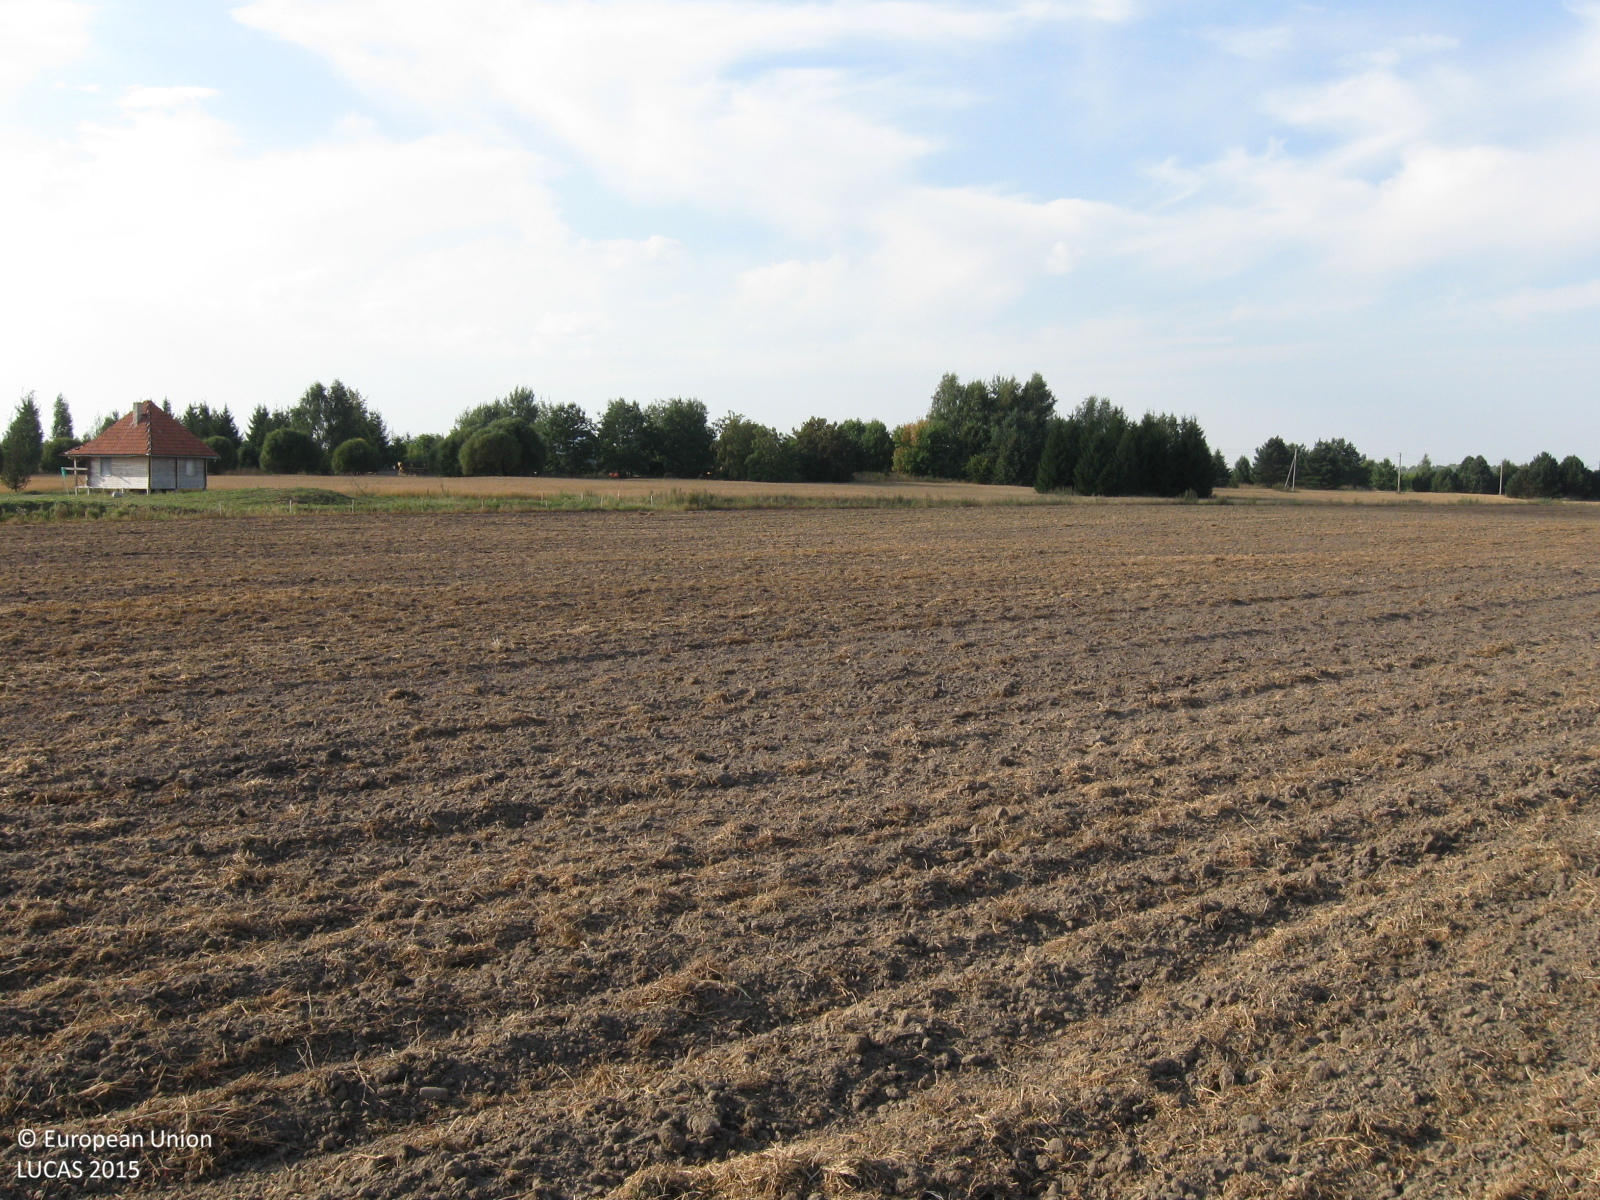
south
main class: Cropland
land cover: Dry pulses
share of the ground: < 10 %
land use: Agriculture (excluding fallow land and kitchen gardens)
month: August
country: LT
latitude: 55.4191
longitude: 22.9445
